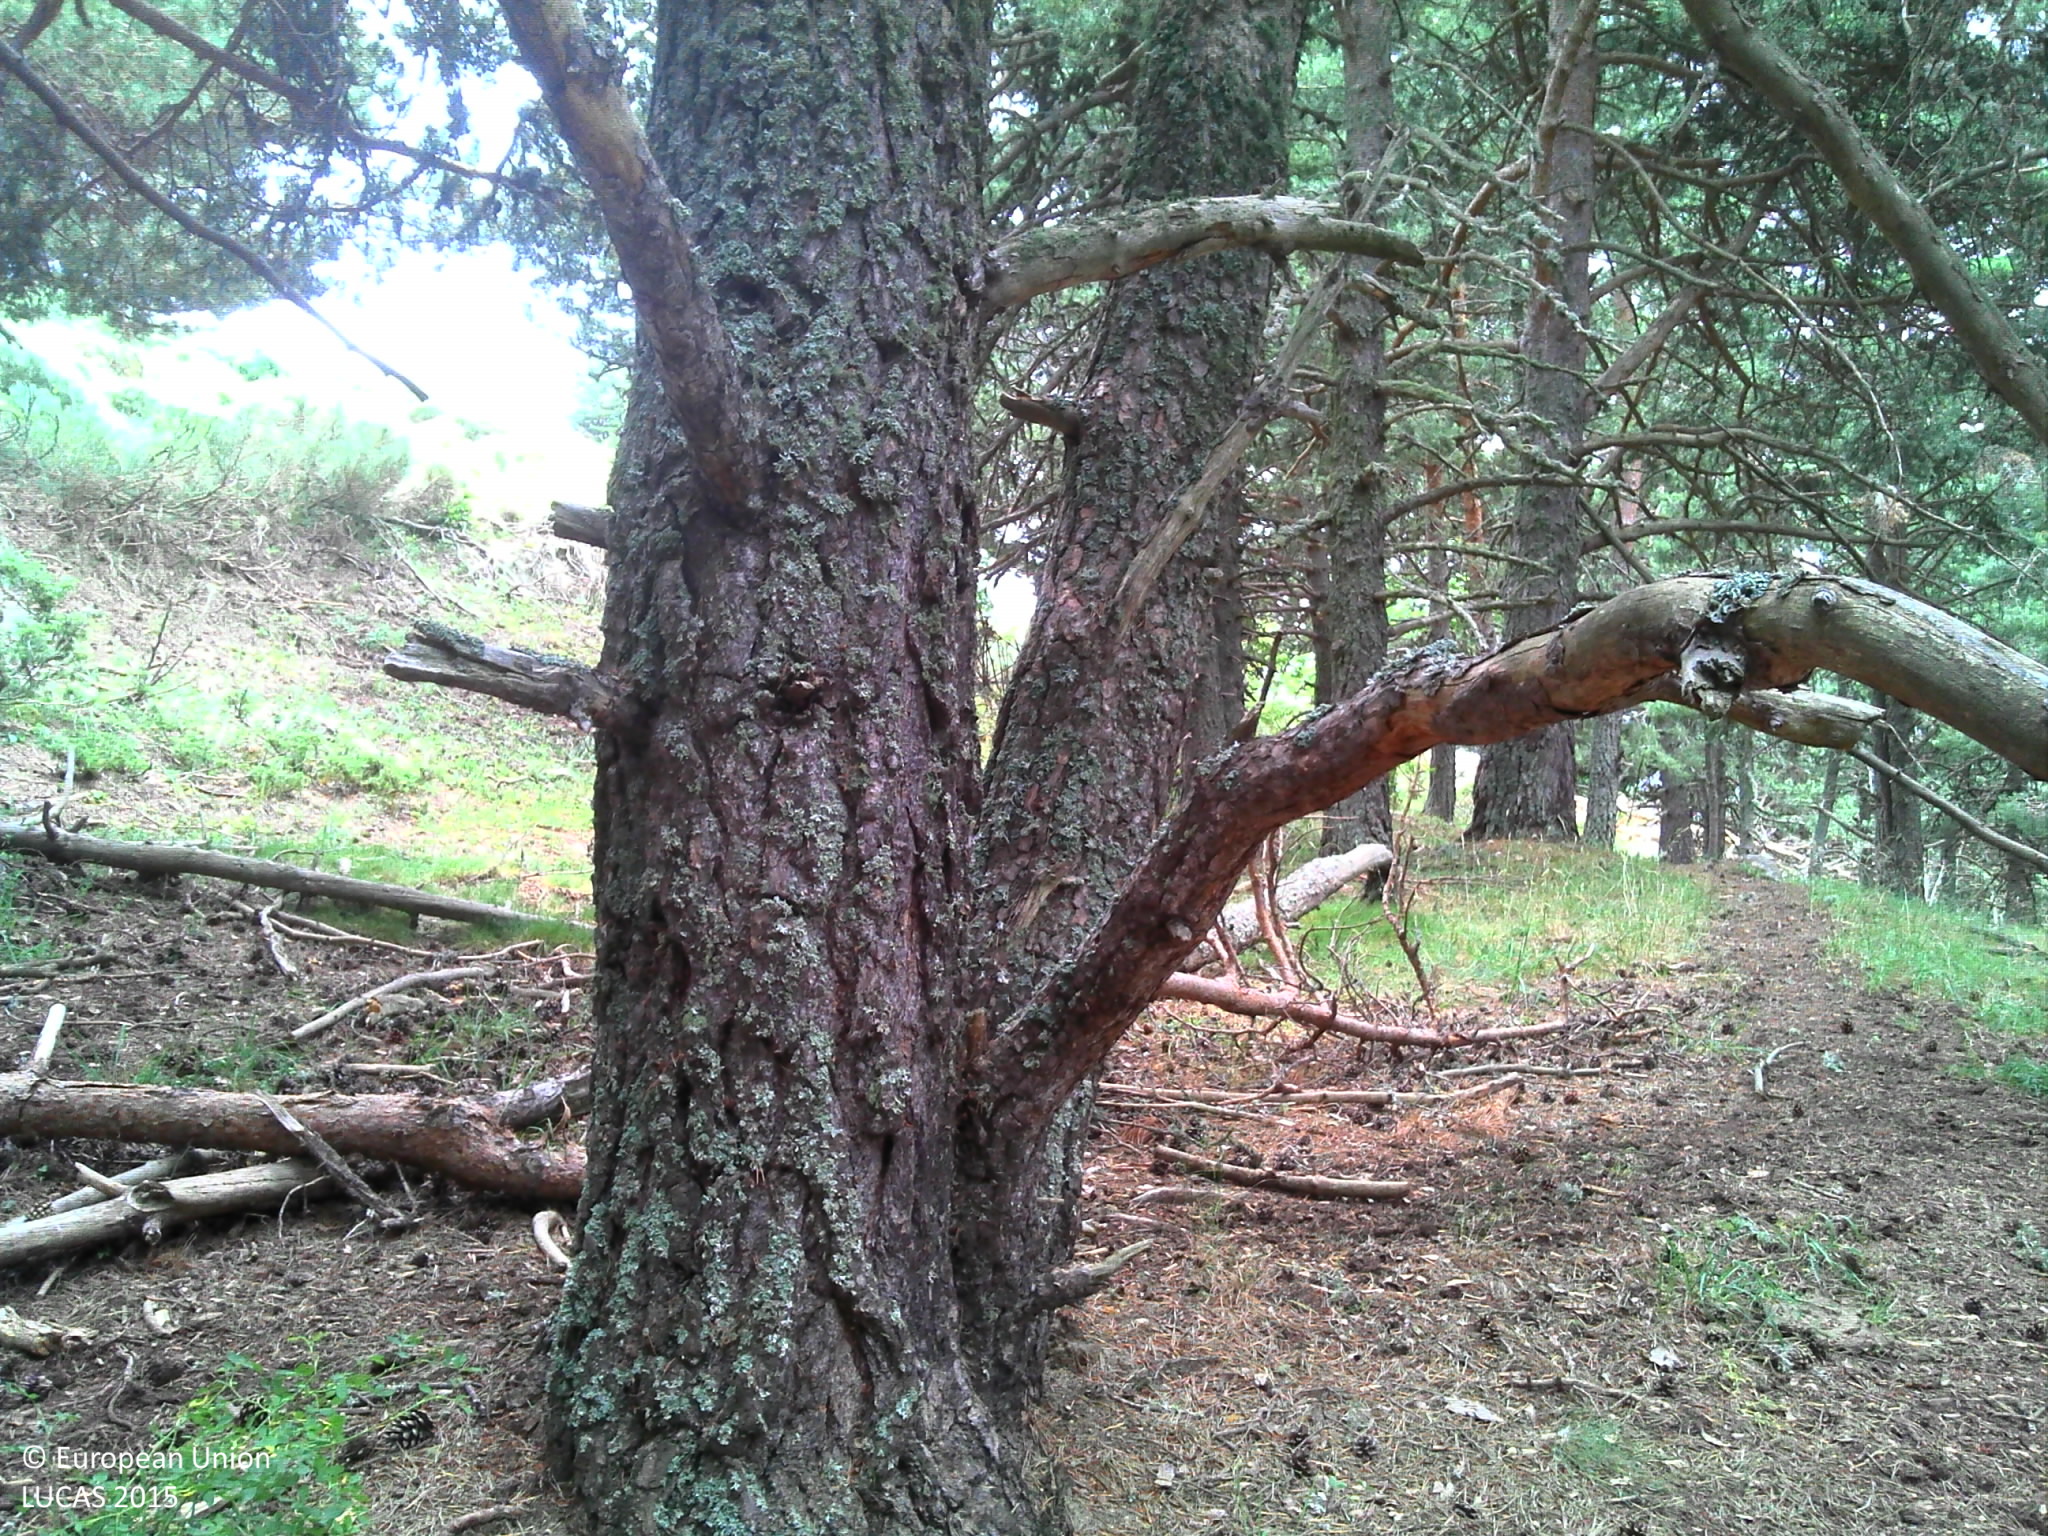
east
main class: Woodland
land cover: Pine dominated coniferous woodland
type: hemiboreal forest and nemoral coniferous forest and mixed broadleaved-coniferous forest
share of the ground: > 75 %
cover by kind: coniferous forest trees 80 %, shrubs 10 %, herbaceous plants 10 %
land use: Agriculture (excluding fallow land and kitchen gardens)
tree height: > 5 m
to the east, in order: Pine dominated coniferous woodland; Tracks; Shrubland without tree cover; Shrubland with sparse tree cover; Shrubland without tree cover; Shrubland with sparse tree cover; Tracks; Single bushes/trees; Shrubland with sparse tree cover; Shrubland without tree cover
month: July
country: FR
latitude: 42.6029
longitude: 2.1492
